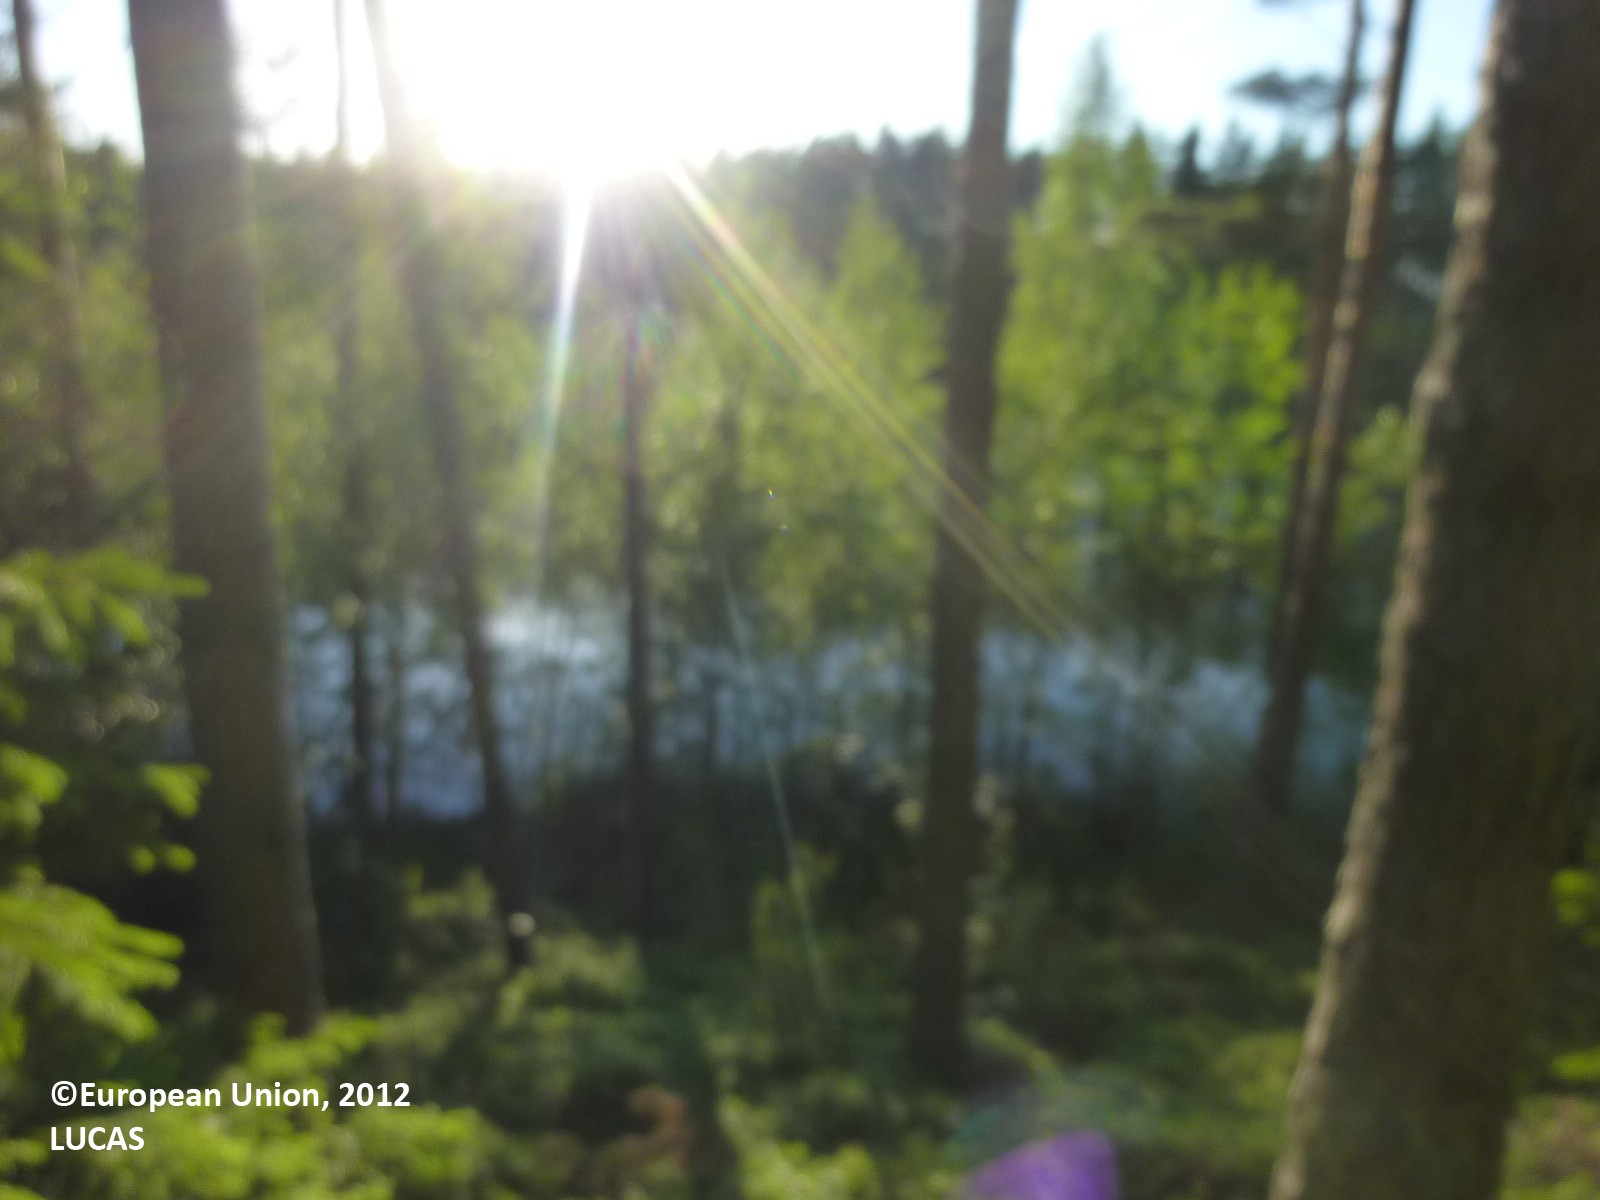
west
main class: Woodland
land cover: Pine dominated coniferous woodland
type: boreal forest
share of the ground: 50 - 75 %
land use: Forestry
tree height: > 5 m
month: June
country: FI
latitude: 60.0500
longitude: 22.4083
